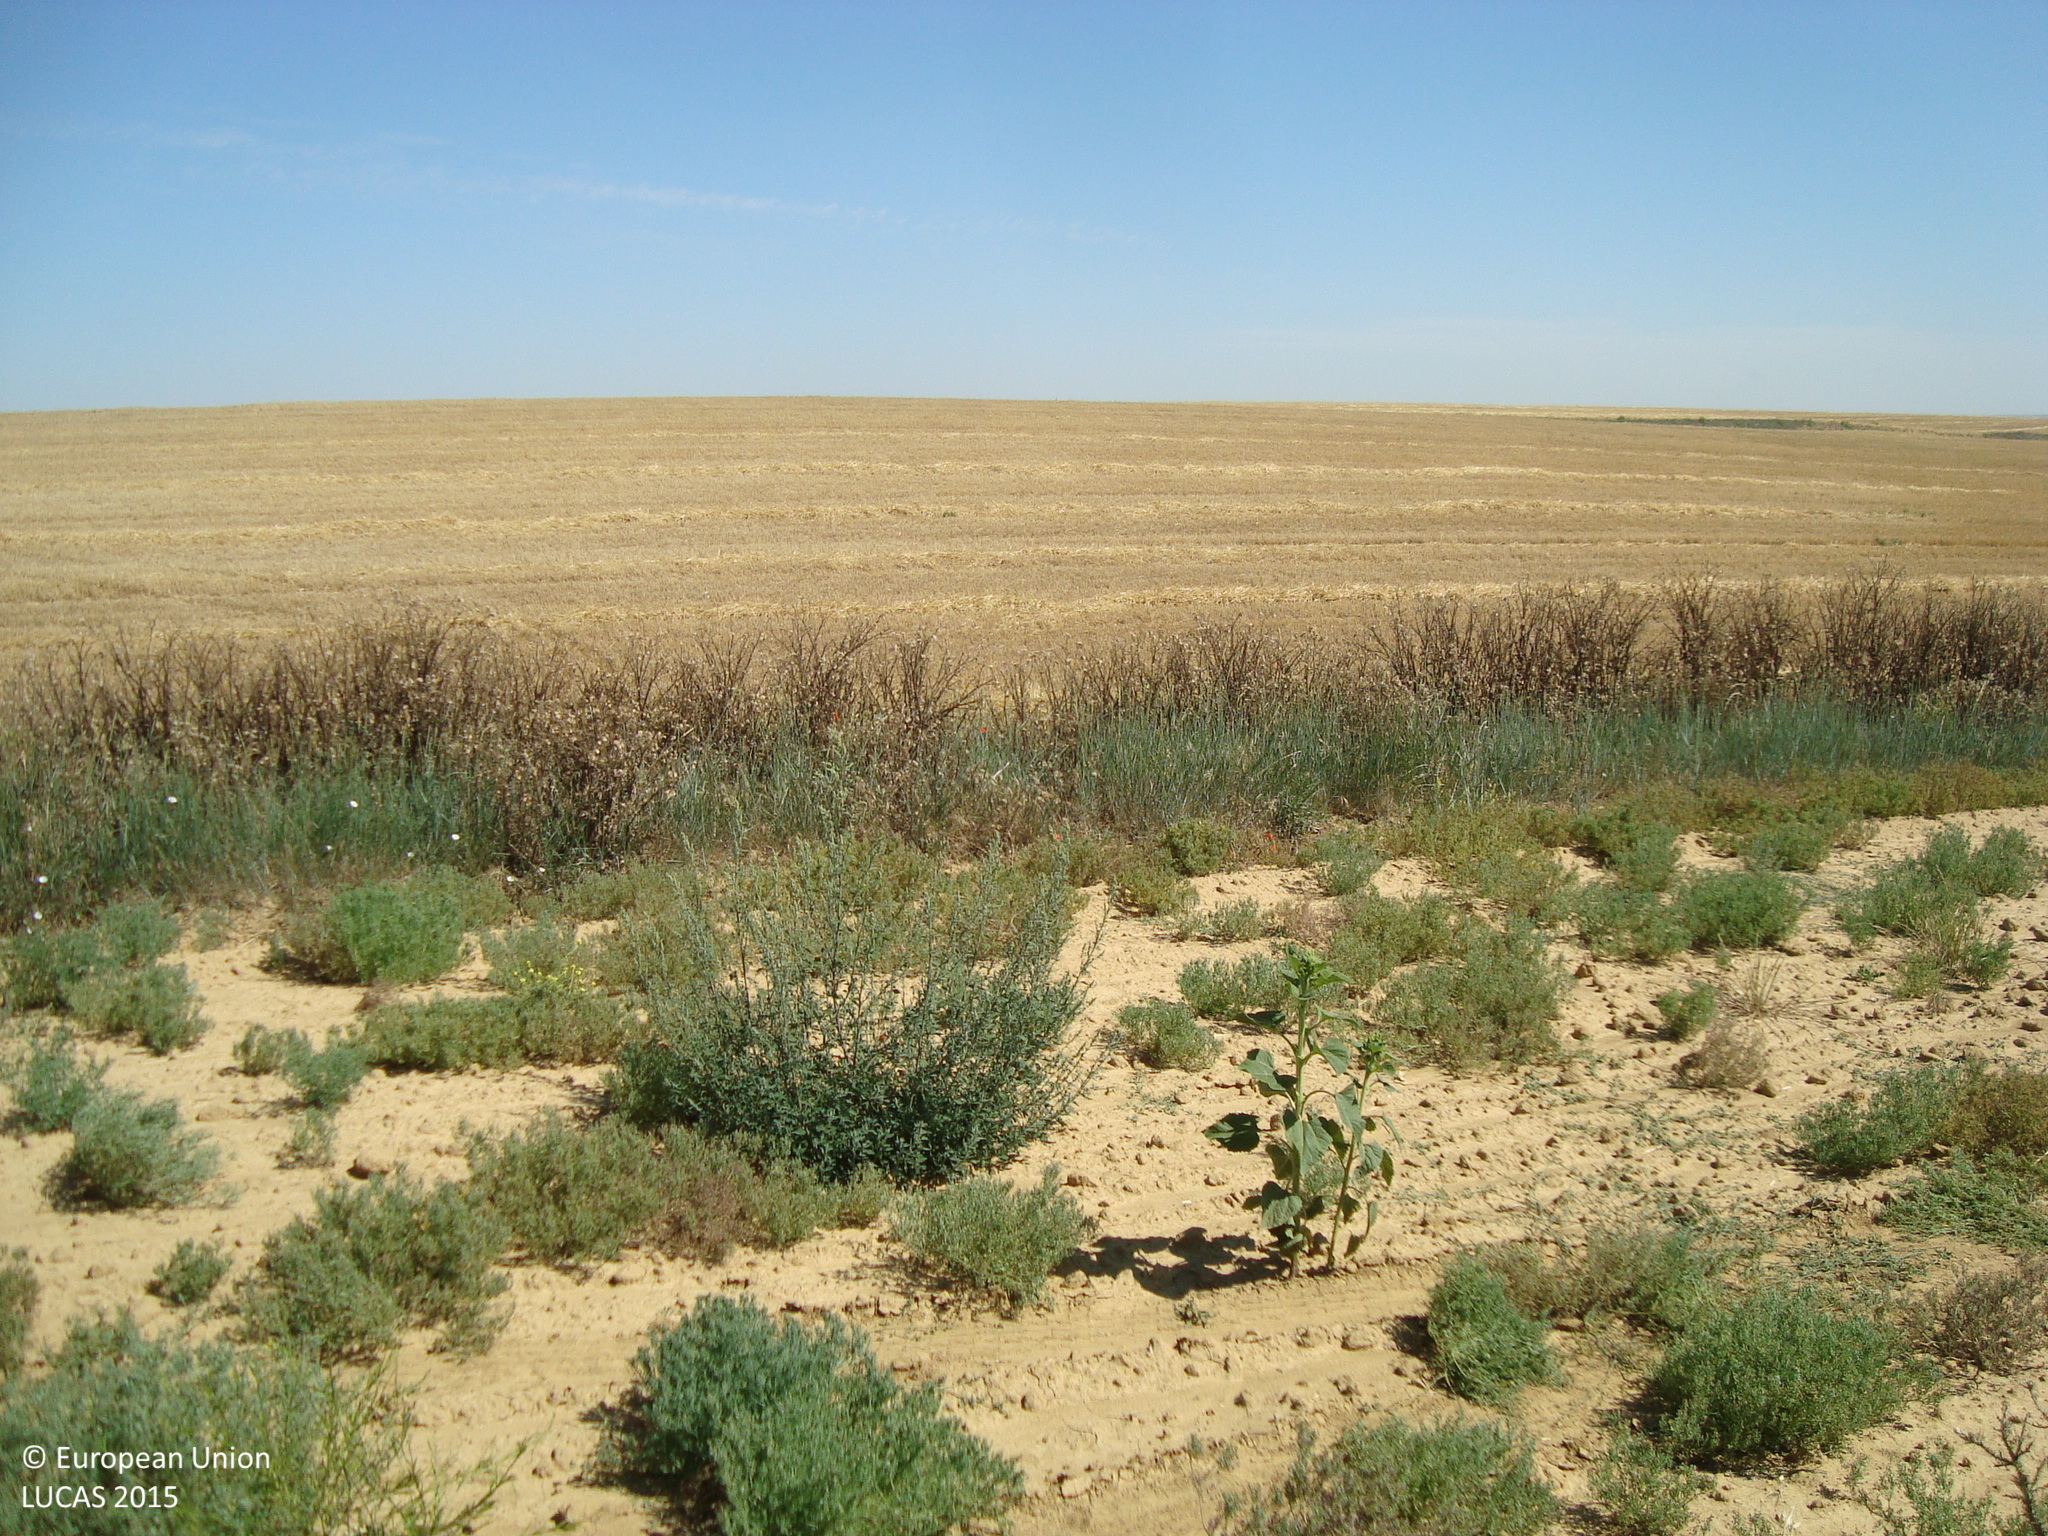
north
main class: Grassland
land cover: Spontaneously vegetated surfaces
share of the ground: 25 - 50 %
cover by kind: unconsolidated bare surface 60 %, herbaceous plants 40 %
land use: Abandoned areas
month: July
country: ES
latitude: 42.0576
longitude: -4.7810
